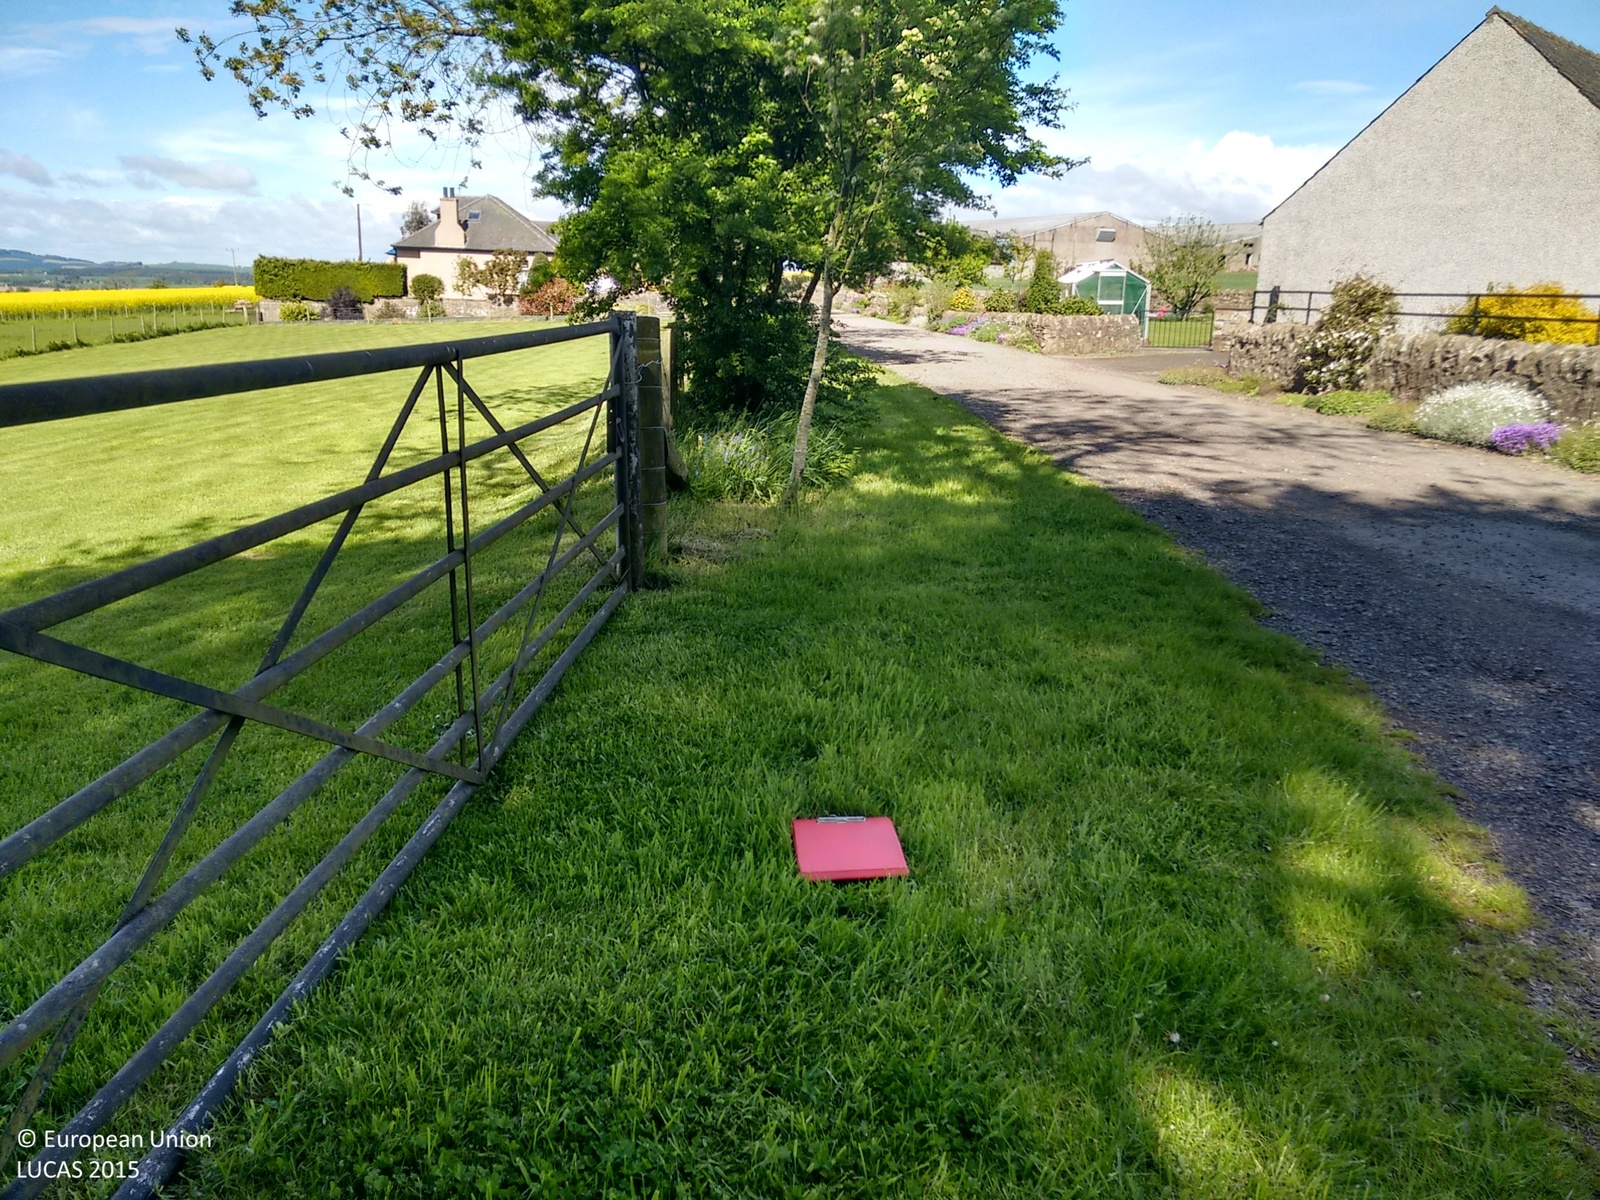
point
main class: Grassland
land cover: Grassland without tree/shrub cover
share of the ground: > 75 %
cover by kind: herbaceous plants 100 %
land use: Agriculture (excluding fallow land and kitchen gardens)
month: May
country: GB
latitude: 56.6568
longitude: -2.6028
